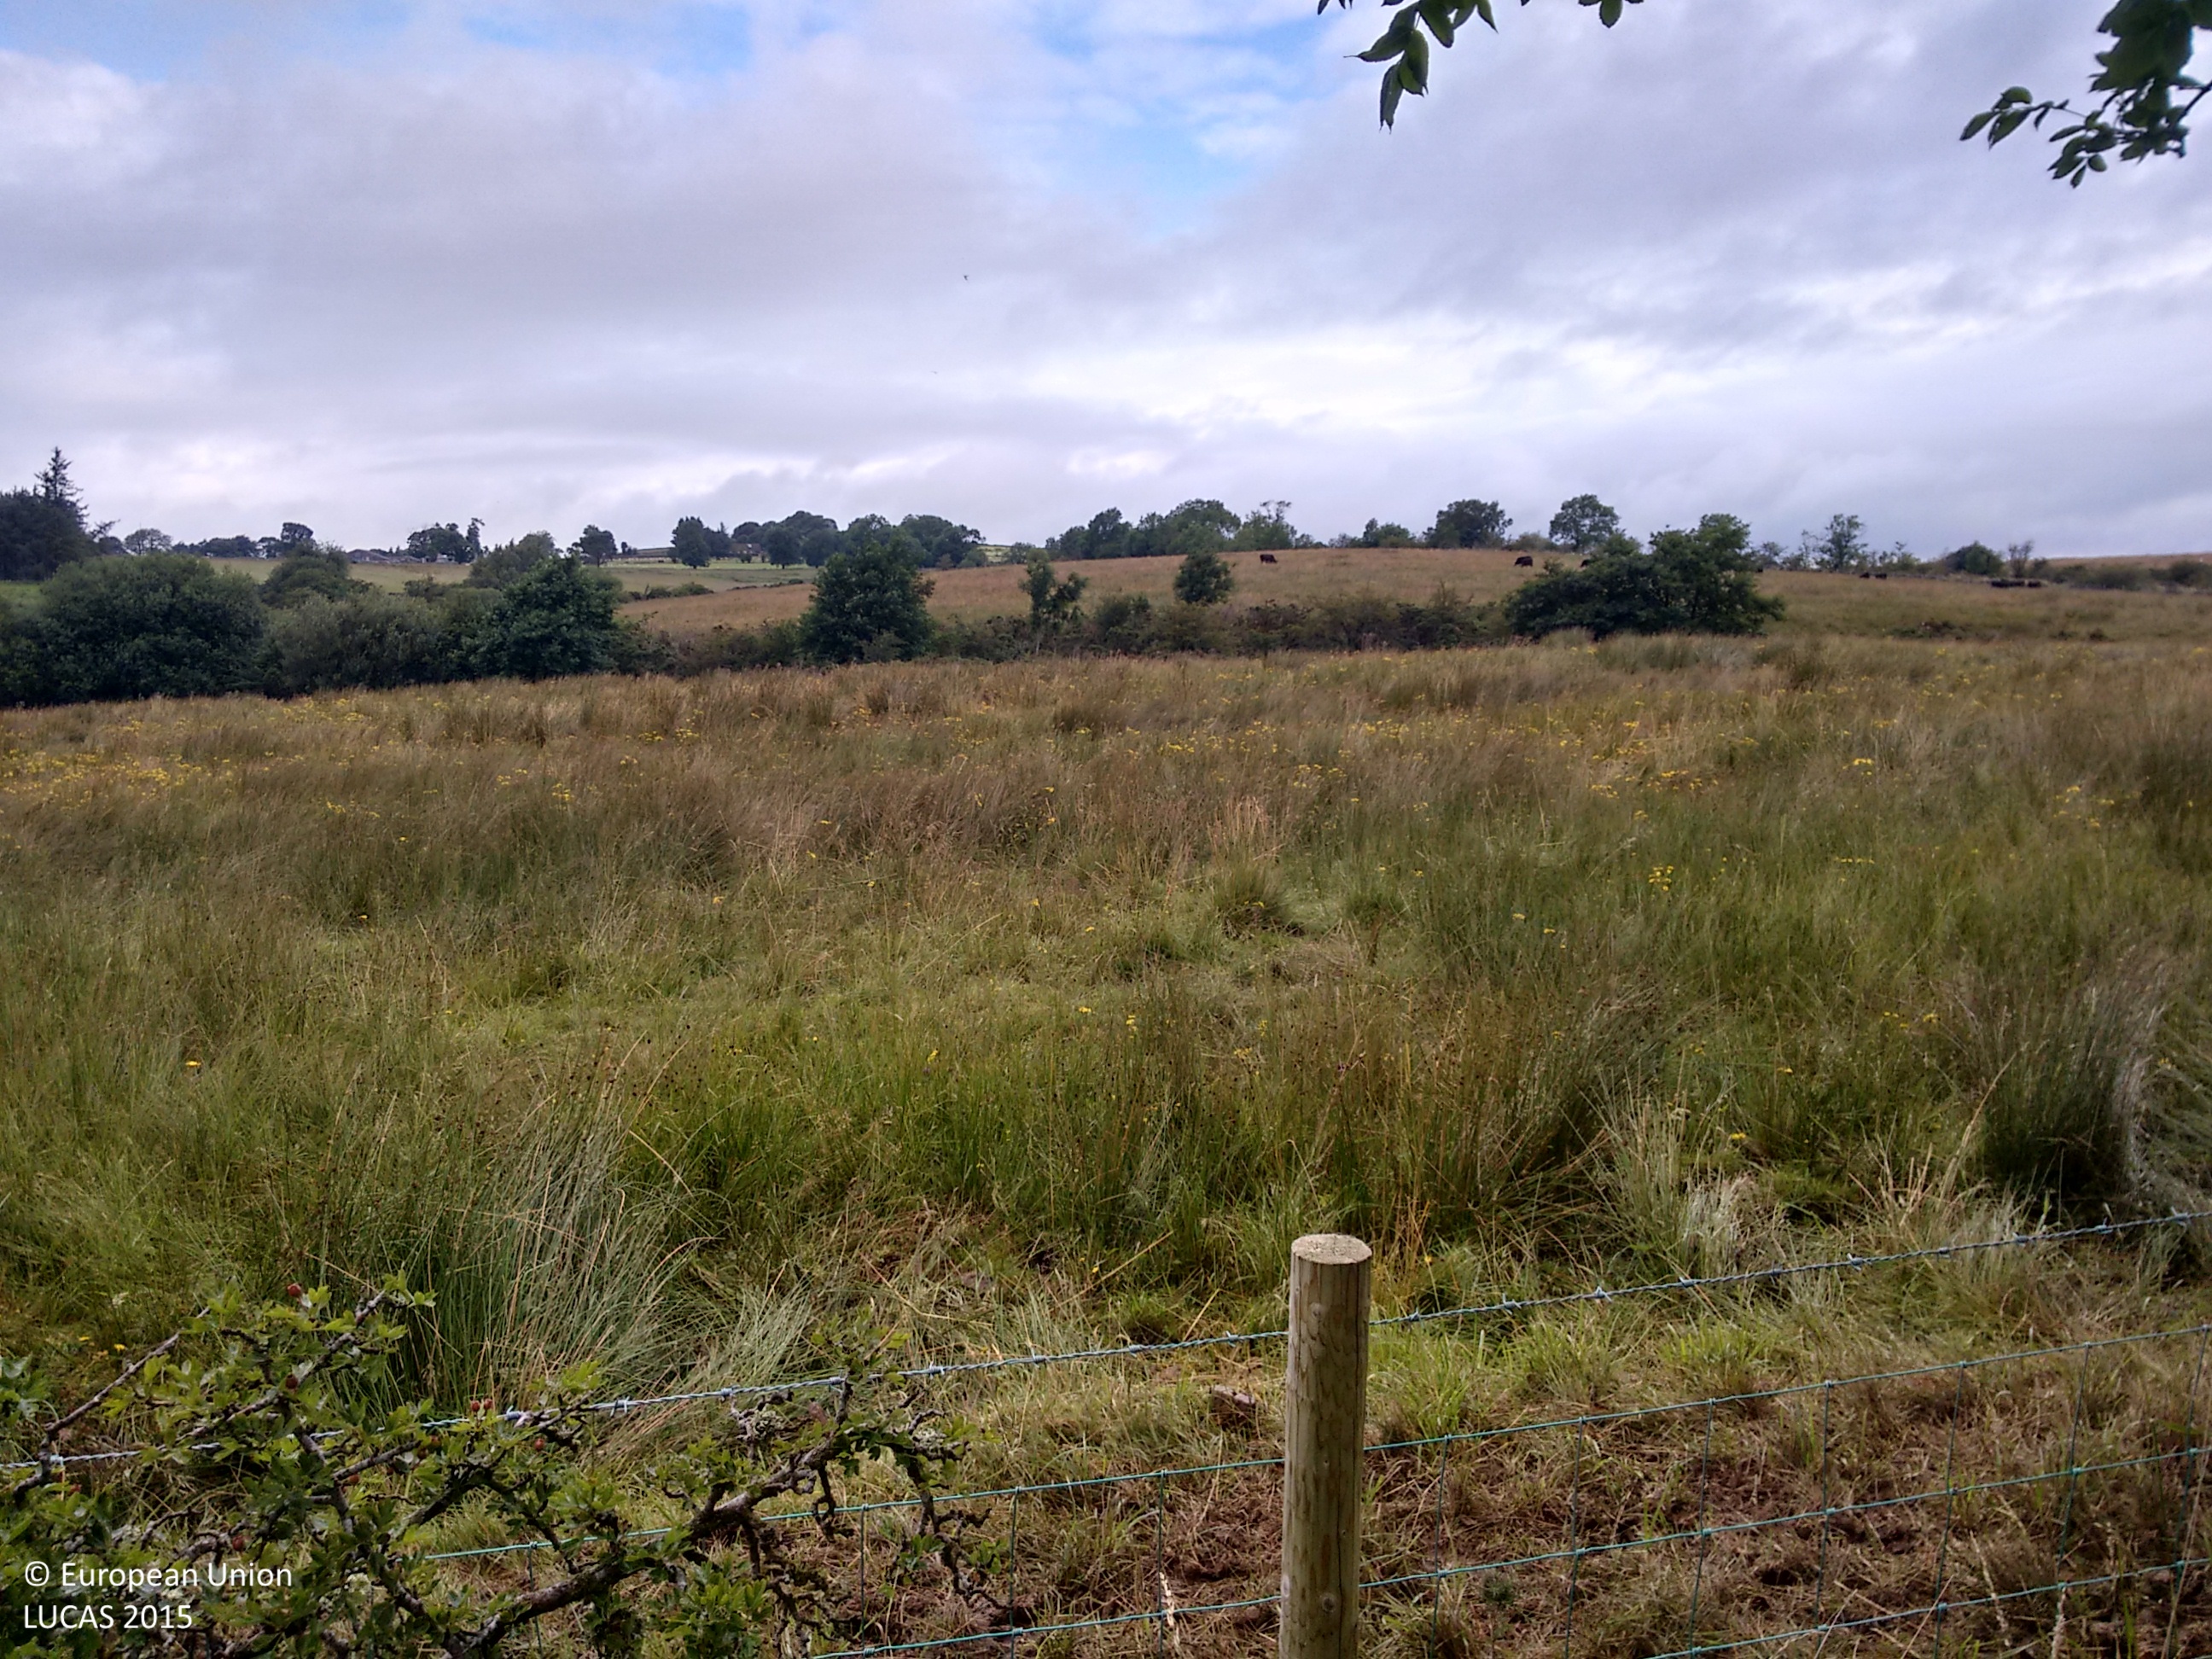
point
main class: Grassland
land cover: Grassland with sparse tree/shrub cover
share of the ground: > 75 %
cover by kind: herbaceous plants 95 %, broadleaved forest trees 5 %
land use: Agriculture (excluding fallow land and kitchen gardens)
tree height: > 5 m
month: August
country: GB
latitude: 54.7088
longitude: -2.9375
